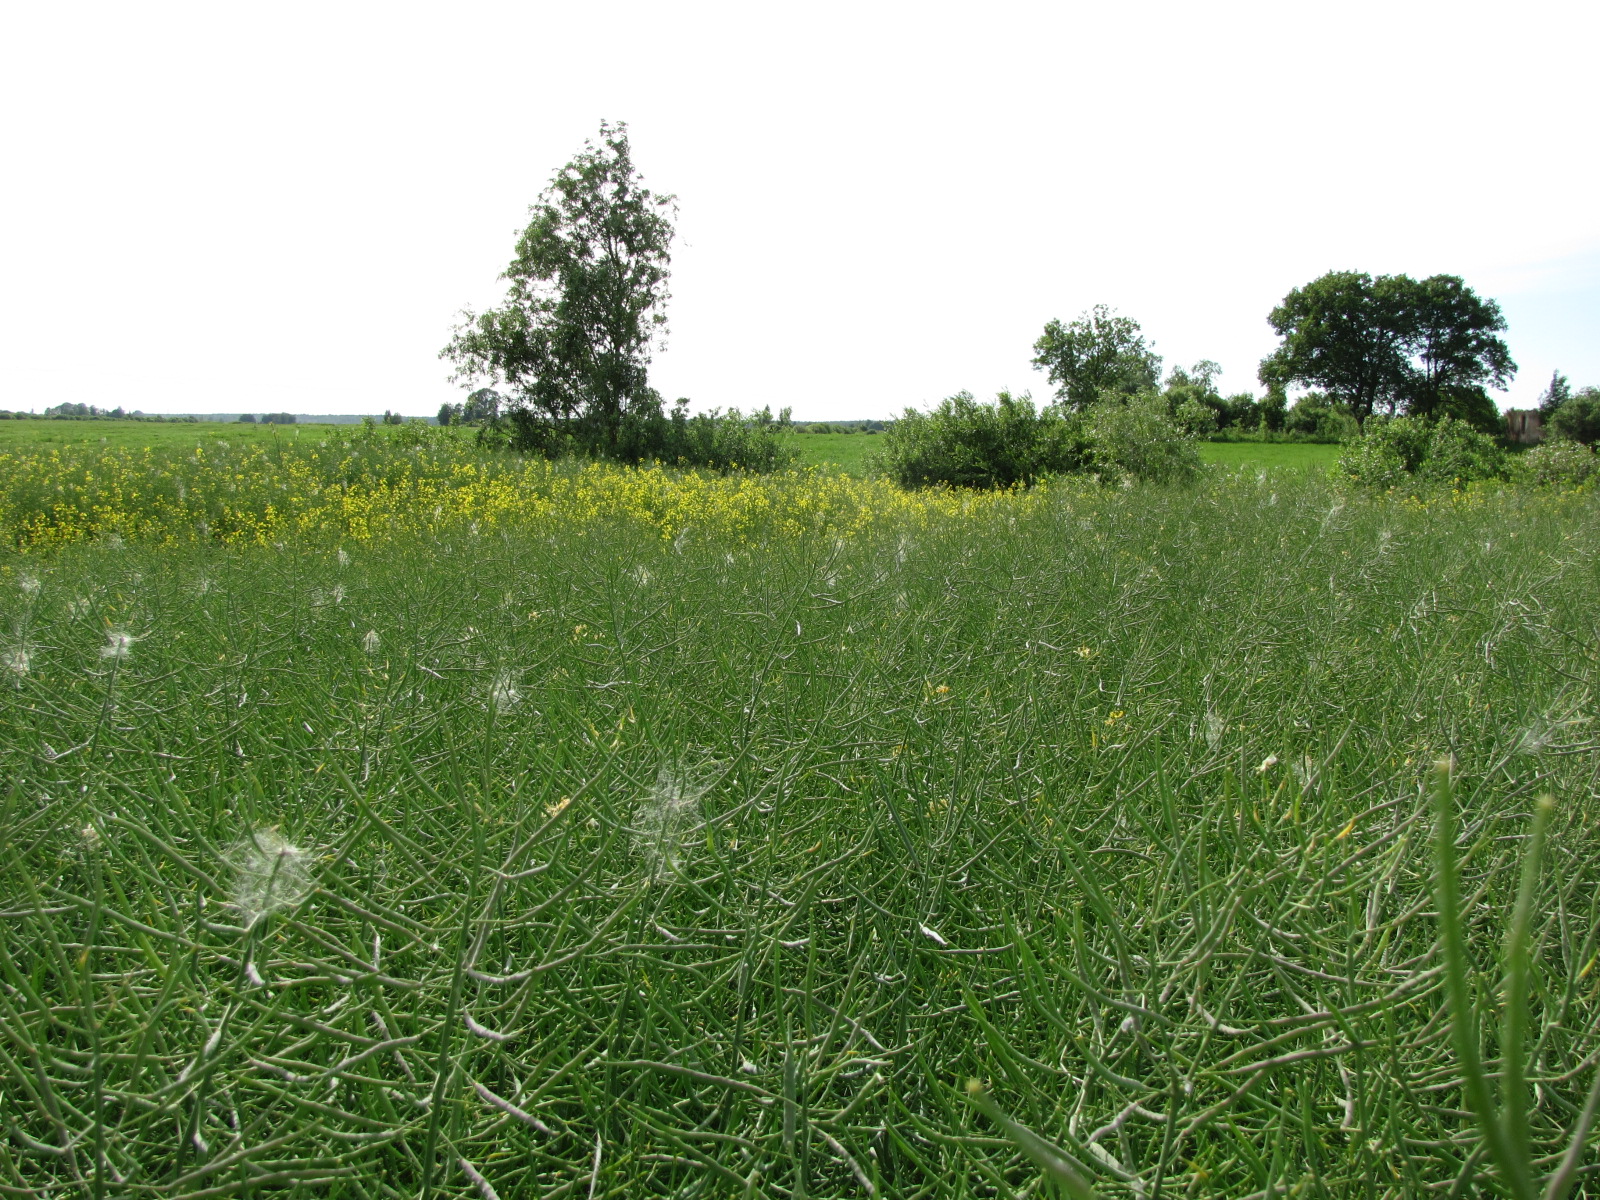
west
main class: Cropland
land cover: Rape and turnip rape
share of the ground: > 75 %
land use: Agriculture (excluding fallow land and kitchen gardens)
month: June
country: LV
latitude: 56.5667
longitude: 23.8329
